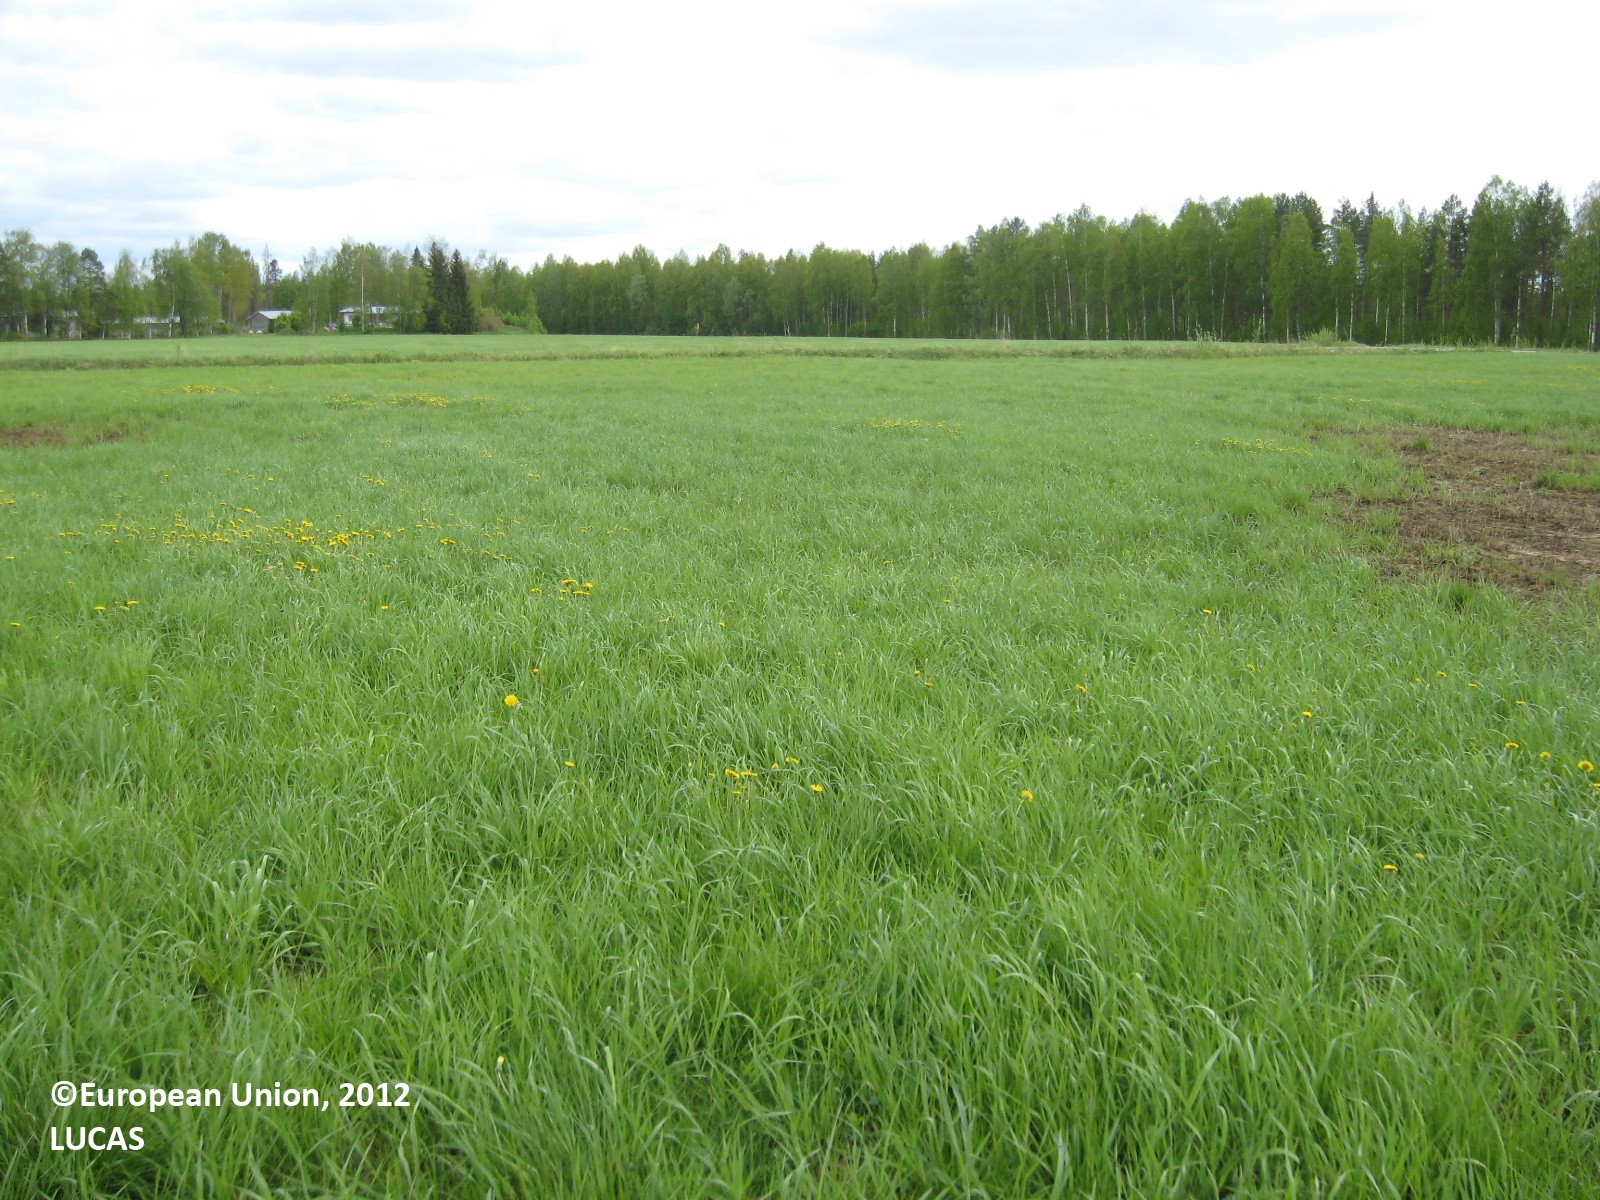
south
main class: Cropland
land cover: Temporary grasslands
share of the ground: > 75 %
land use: Agriculture (excluding fallow land and kitchen gardens)
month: May
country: FI
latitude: 61.8122
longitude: 22.5295
